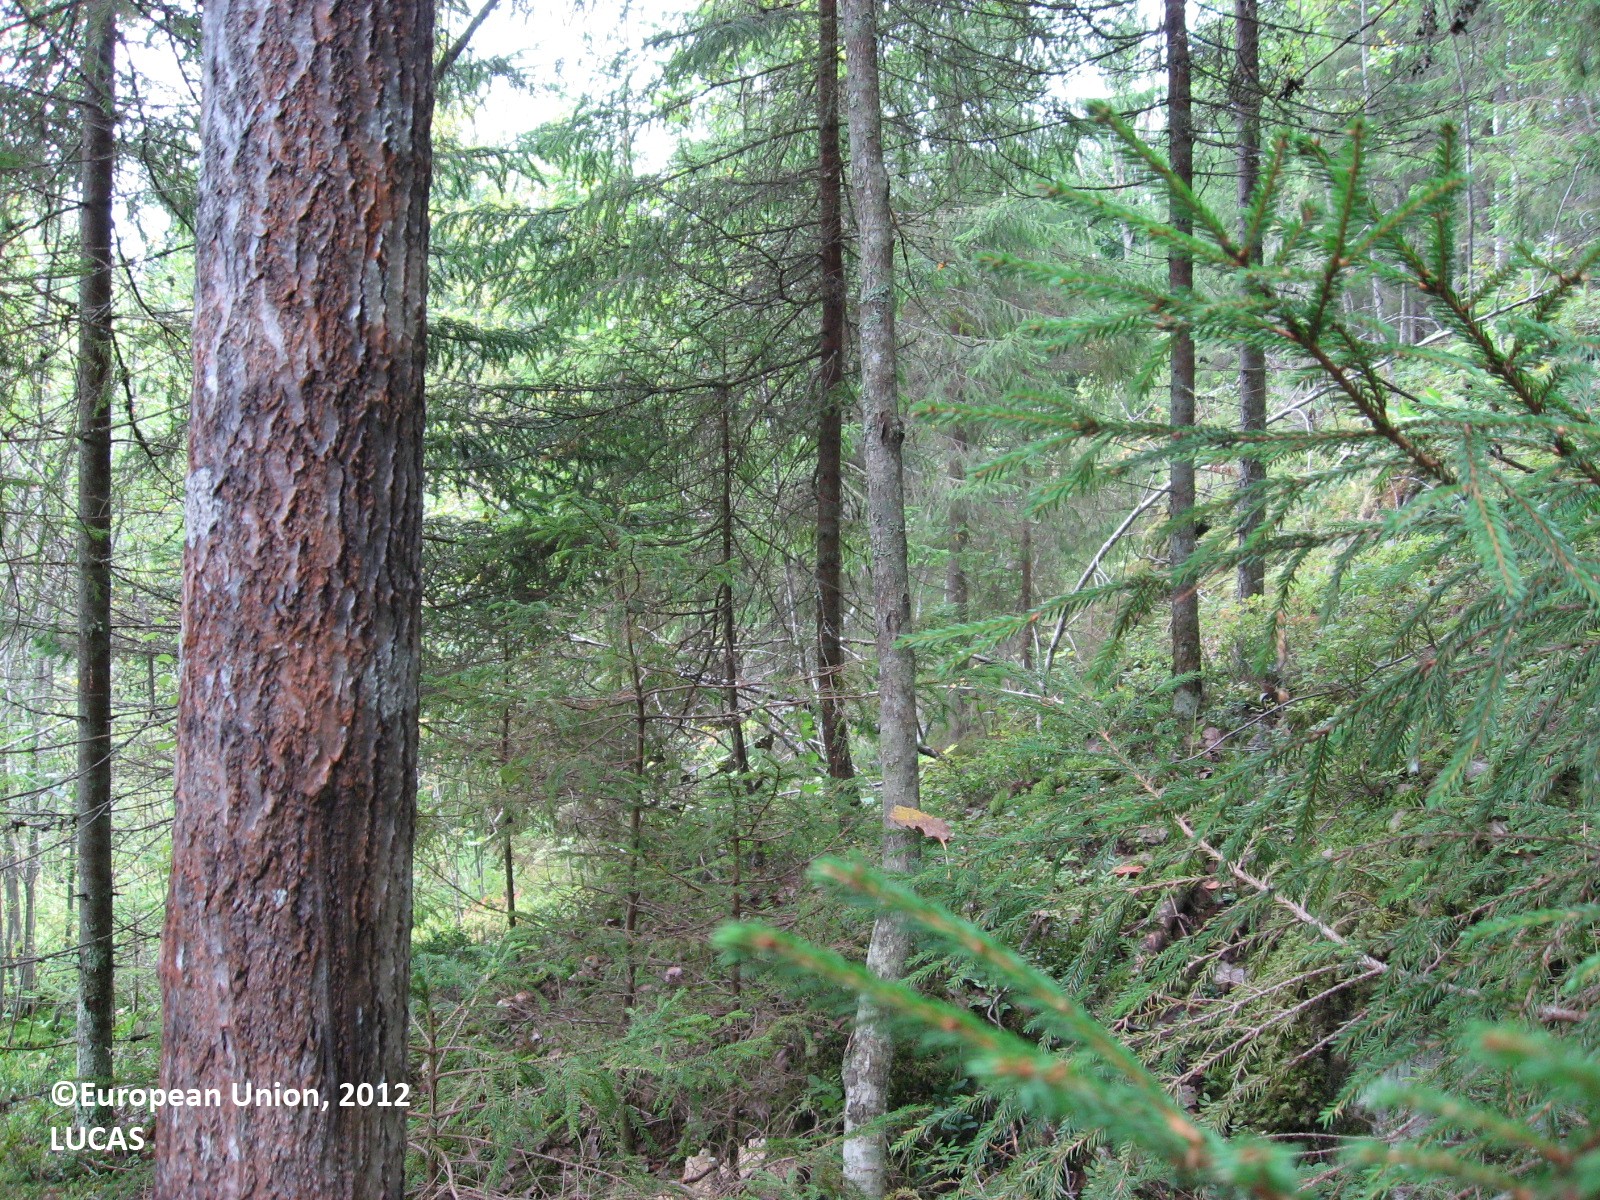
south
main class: Woodland
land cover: Spruce dominated mixed woodland
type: boreal forest
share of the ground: > 75 %
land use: Forestry
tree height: > 5 m
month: August
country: FI
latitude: 60.9108
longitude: 25.5612
